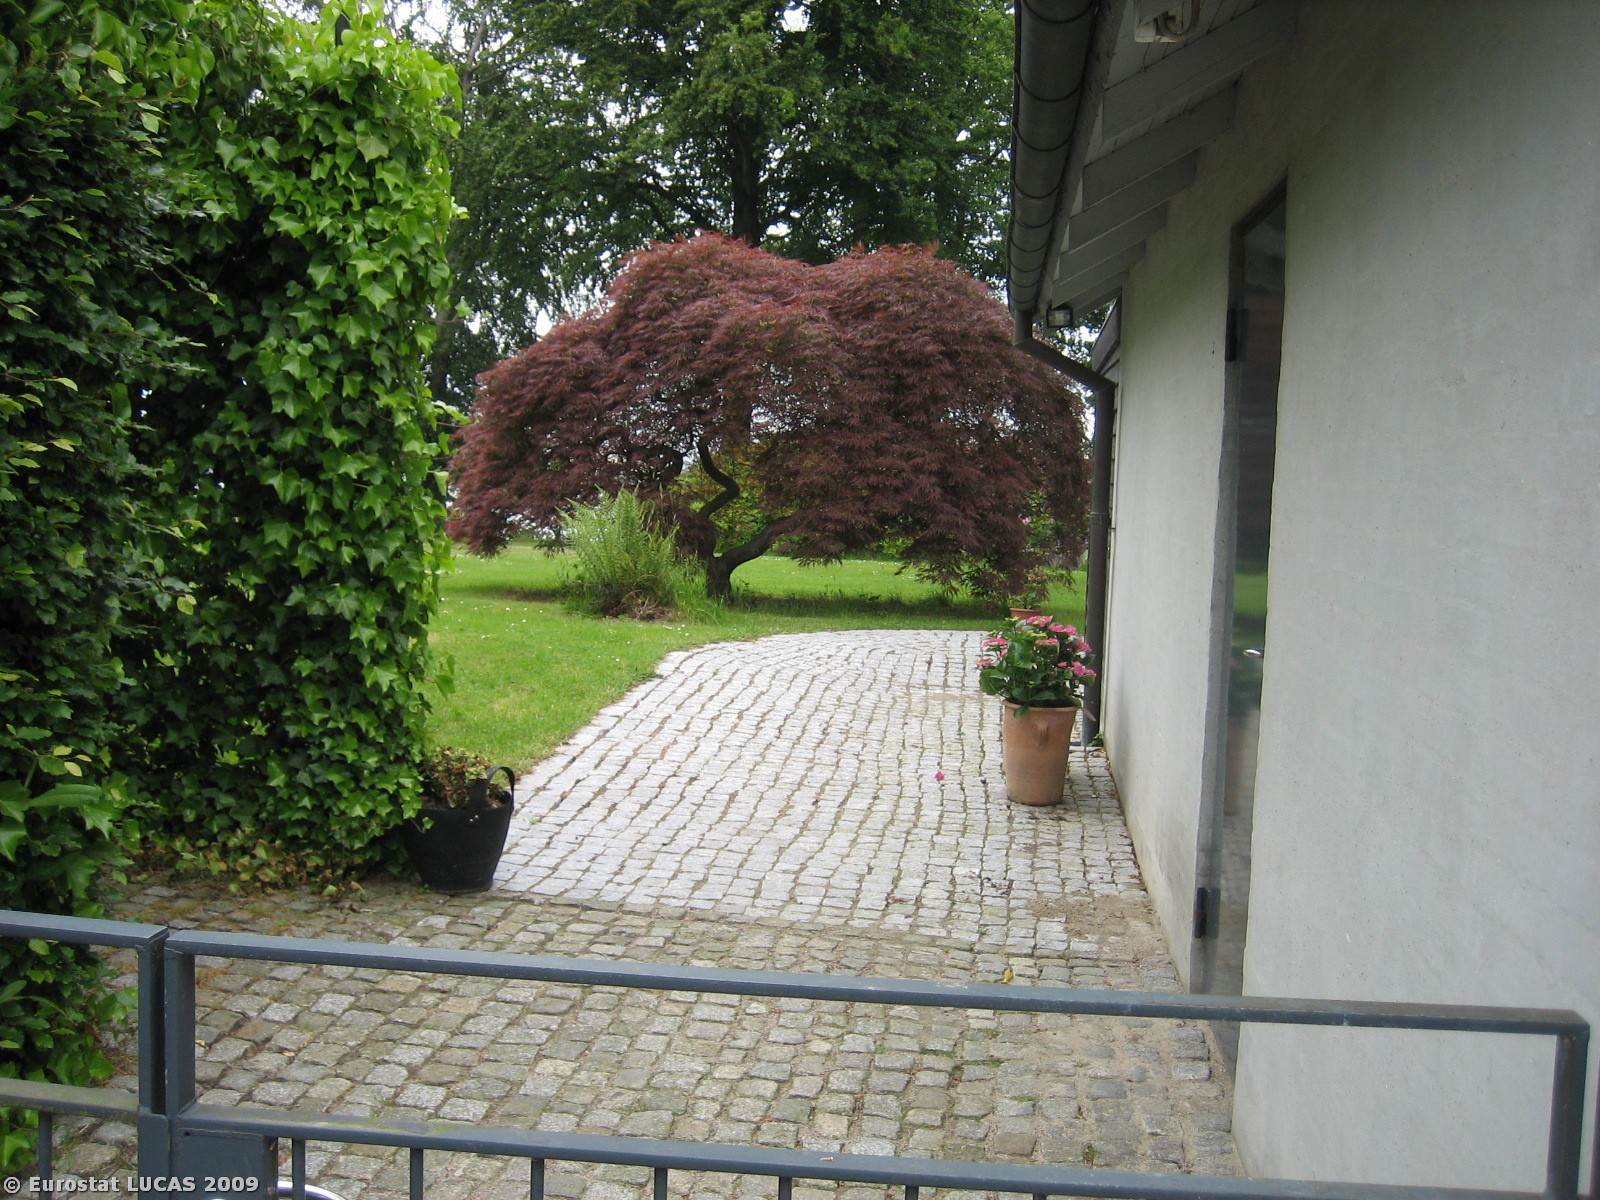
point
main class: Grassland
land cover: Grassland without tree/shrub cover
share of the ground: > 75 %
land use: Residential
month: June
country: DK
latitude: 56.1336
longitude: 10.2089
